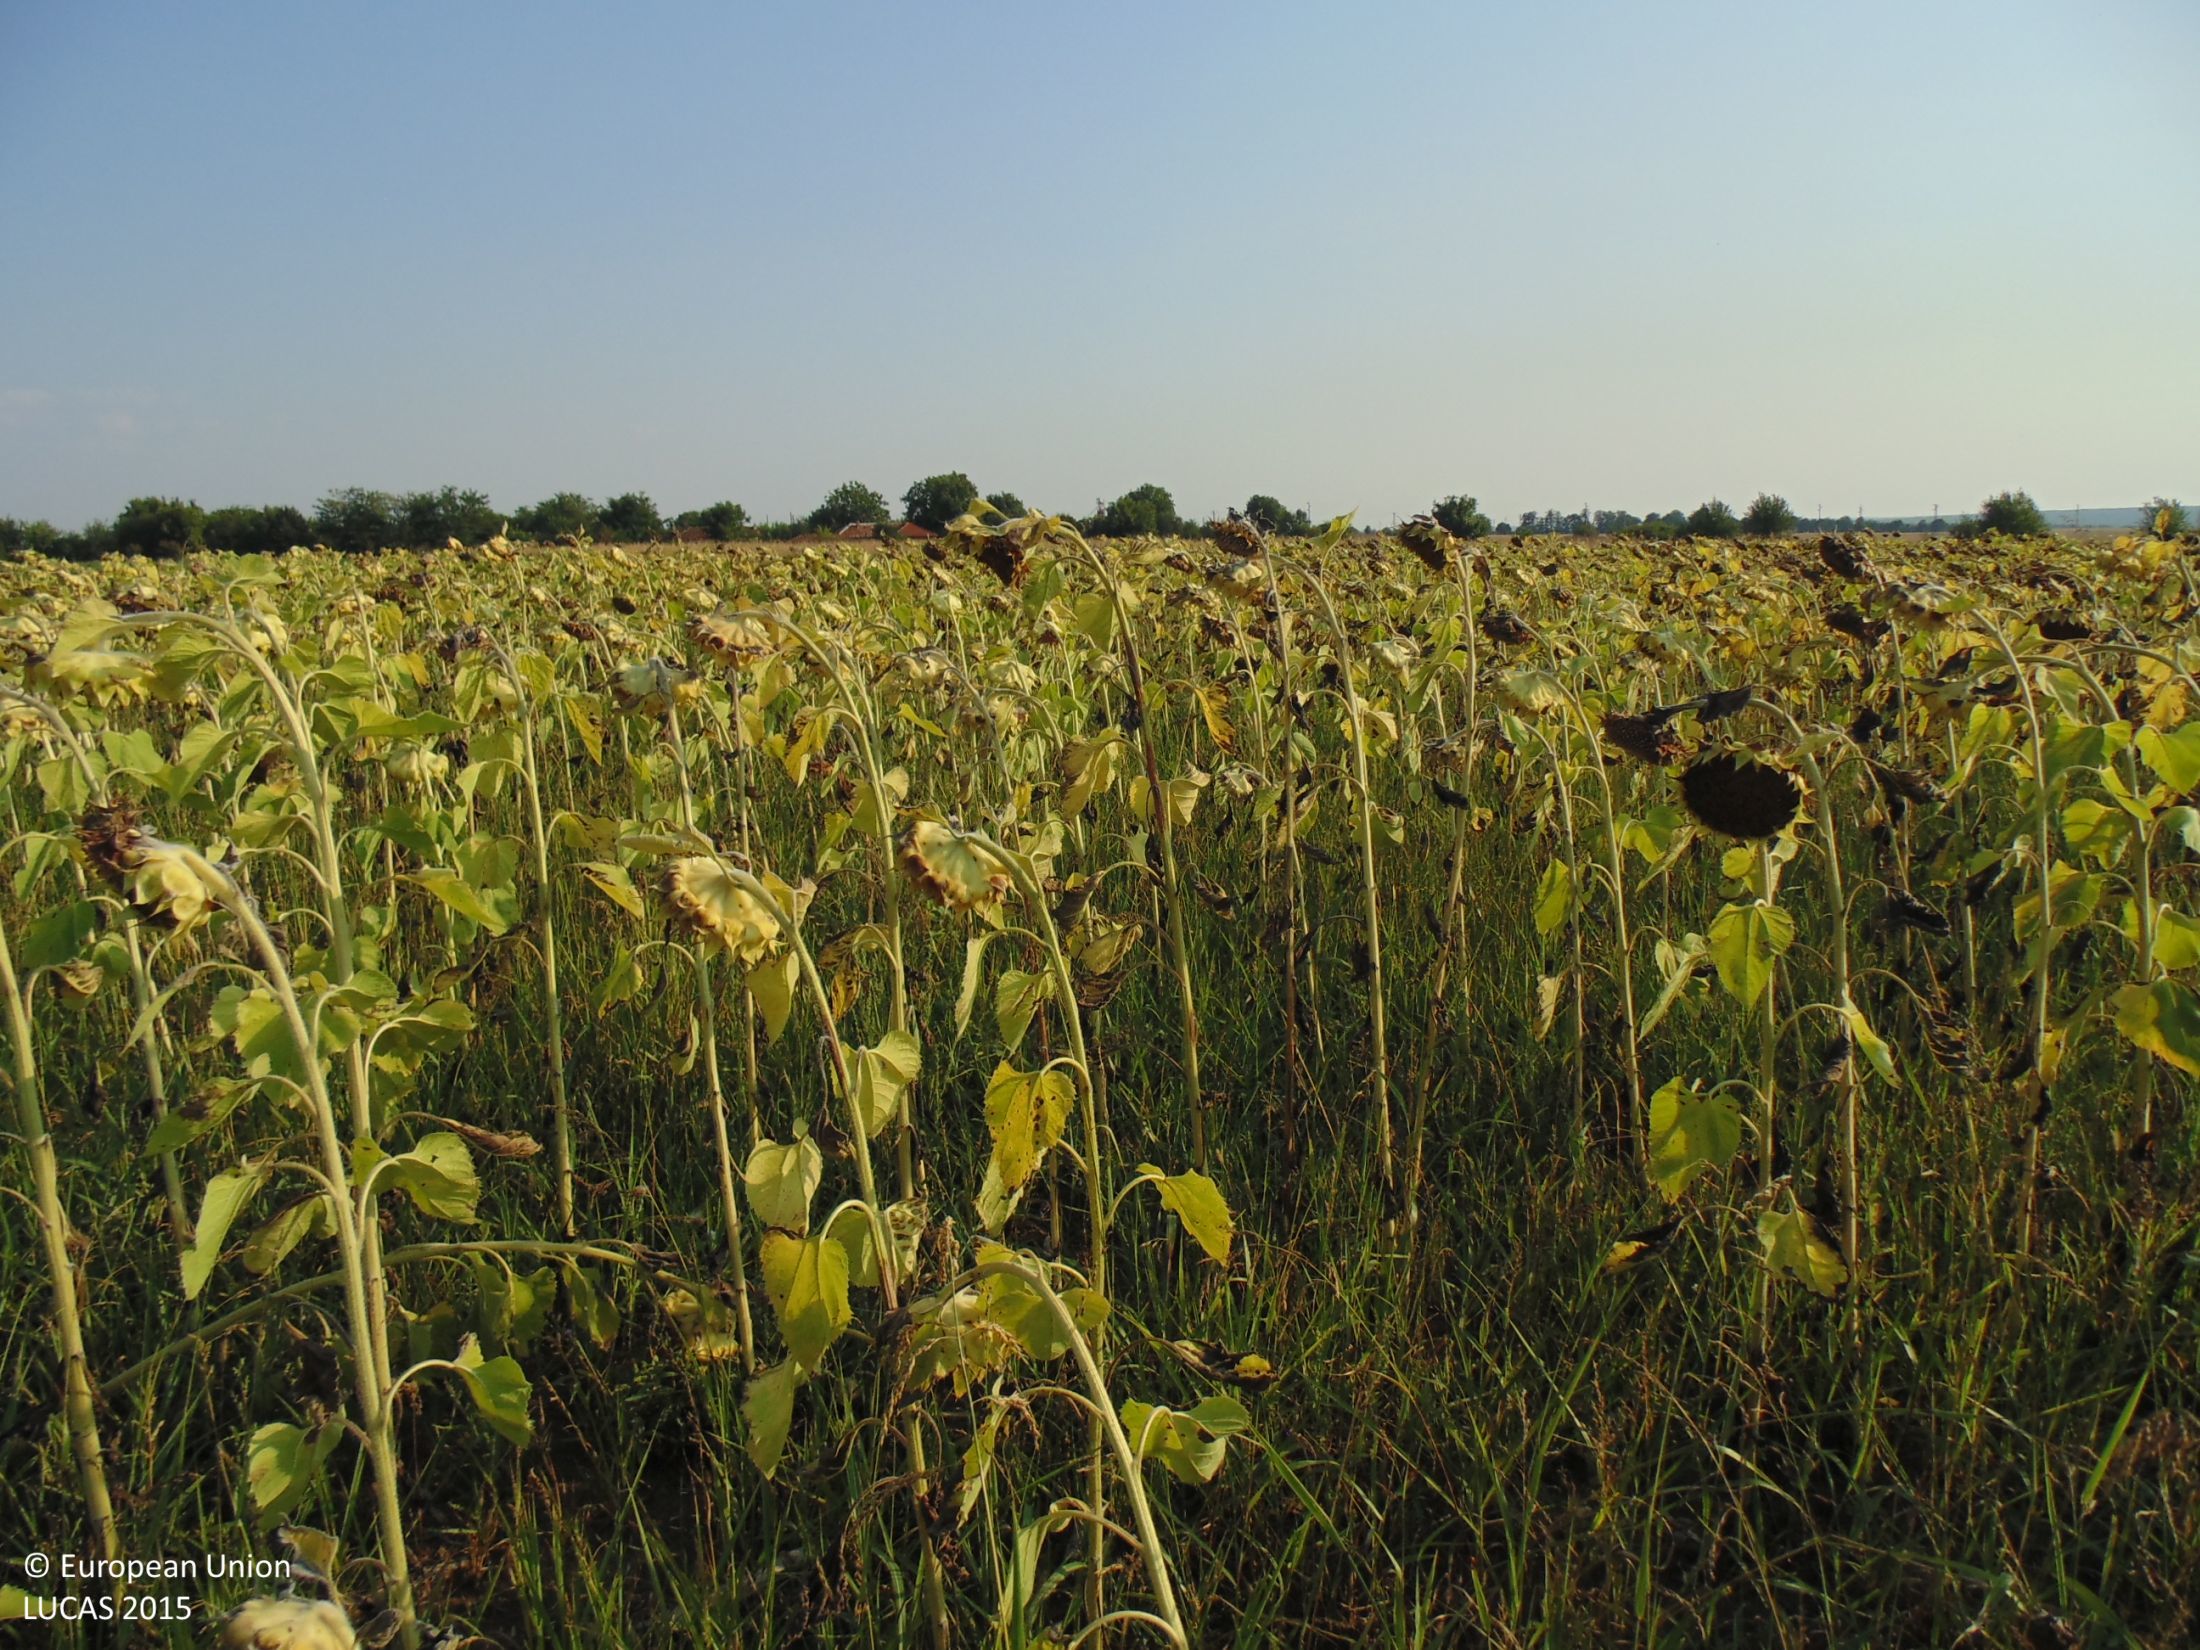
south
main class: Cropland
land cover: Sunflower
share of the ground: > 75 %
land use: Agriculture (excluding fallow land and kitchen gardens)
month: August
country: BG
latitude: 43.8538
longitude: 27.3358
